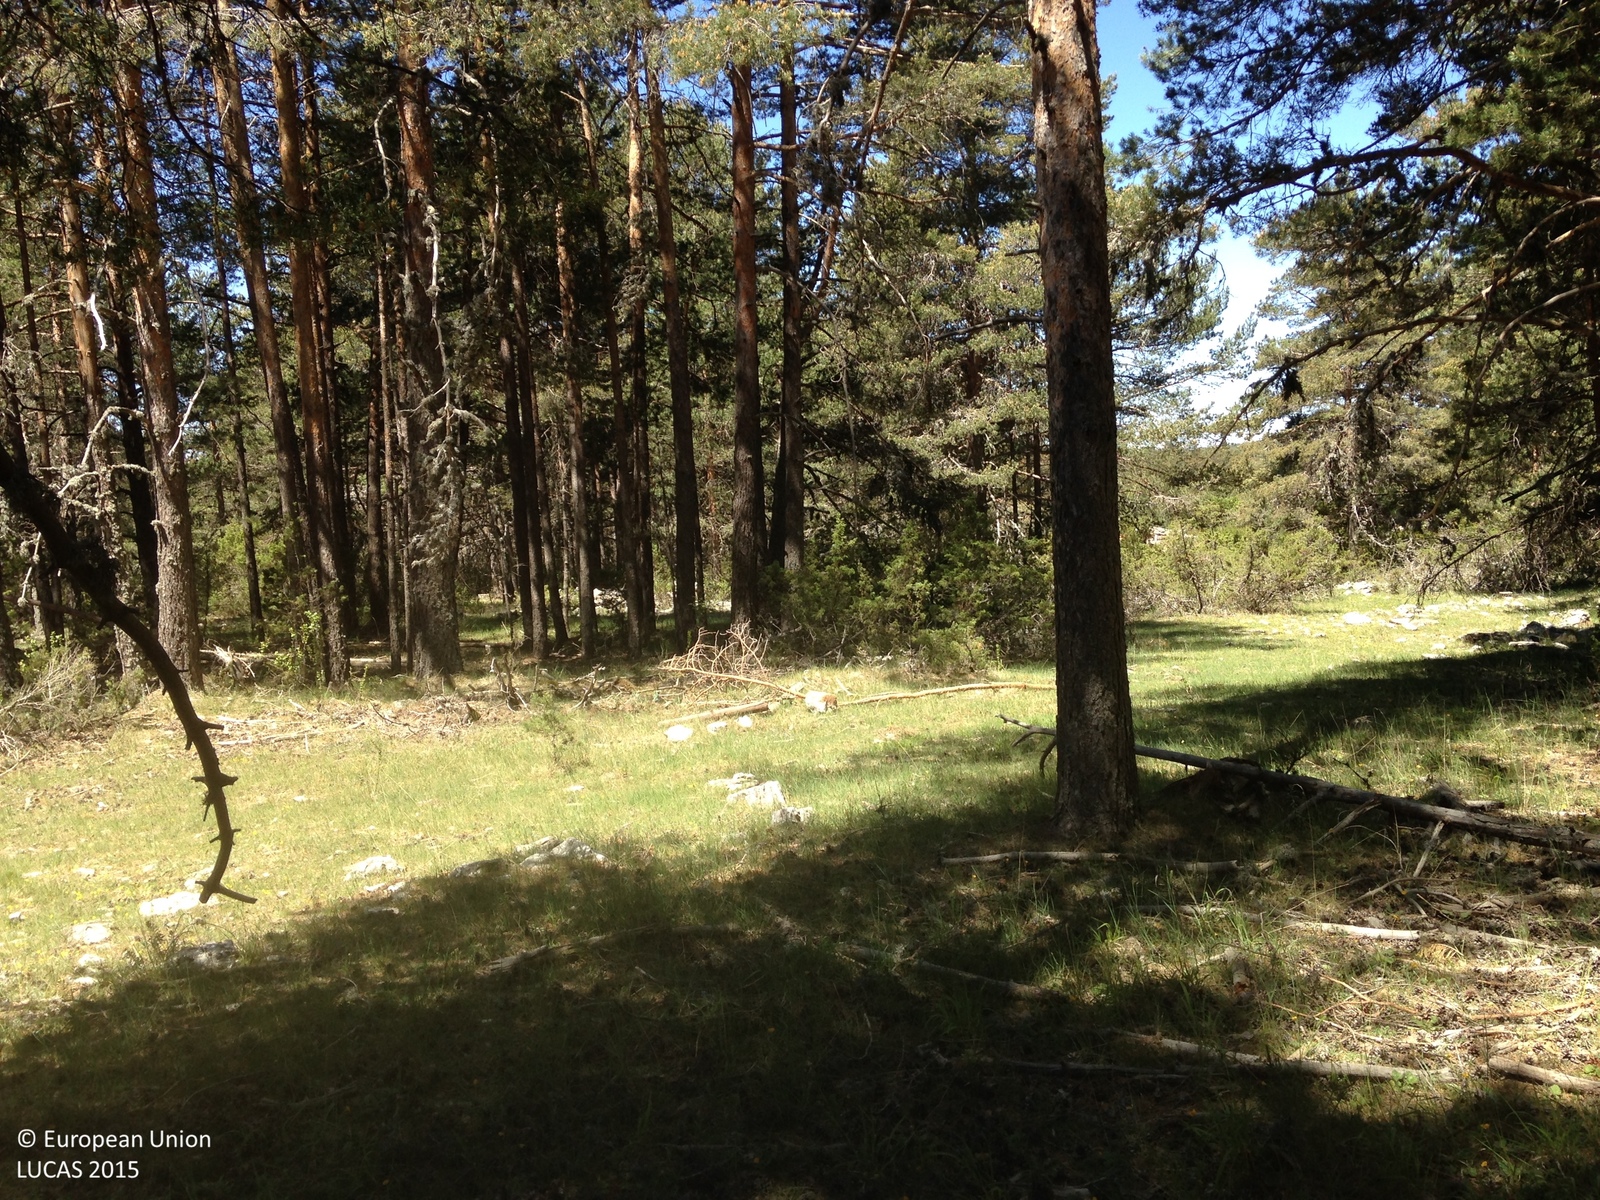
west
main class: Woodland
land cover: Pine dominated coniferous woodland
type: coniferous forest of the mediterranean region
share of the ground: 50 - 75 %
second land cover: Grassland without tree/shrub cover
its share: 50 - 75 %
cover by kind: coniferous forest trees 65 %, herbaceous plants 25 %, shrubs 10 %
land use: Forestry
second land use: Agriculture (excluding fallow land and kitchen gardens)
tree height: > 5 m
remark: Clear cut
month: May
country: ES
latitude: 40.5380
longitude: -1.9558
